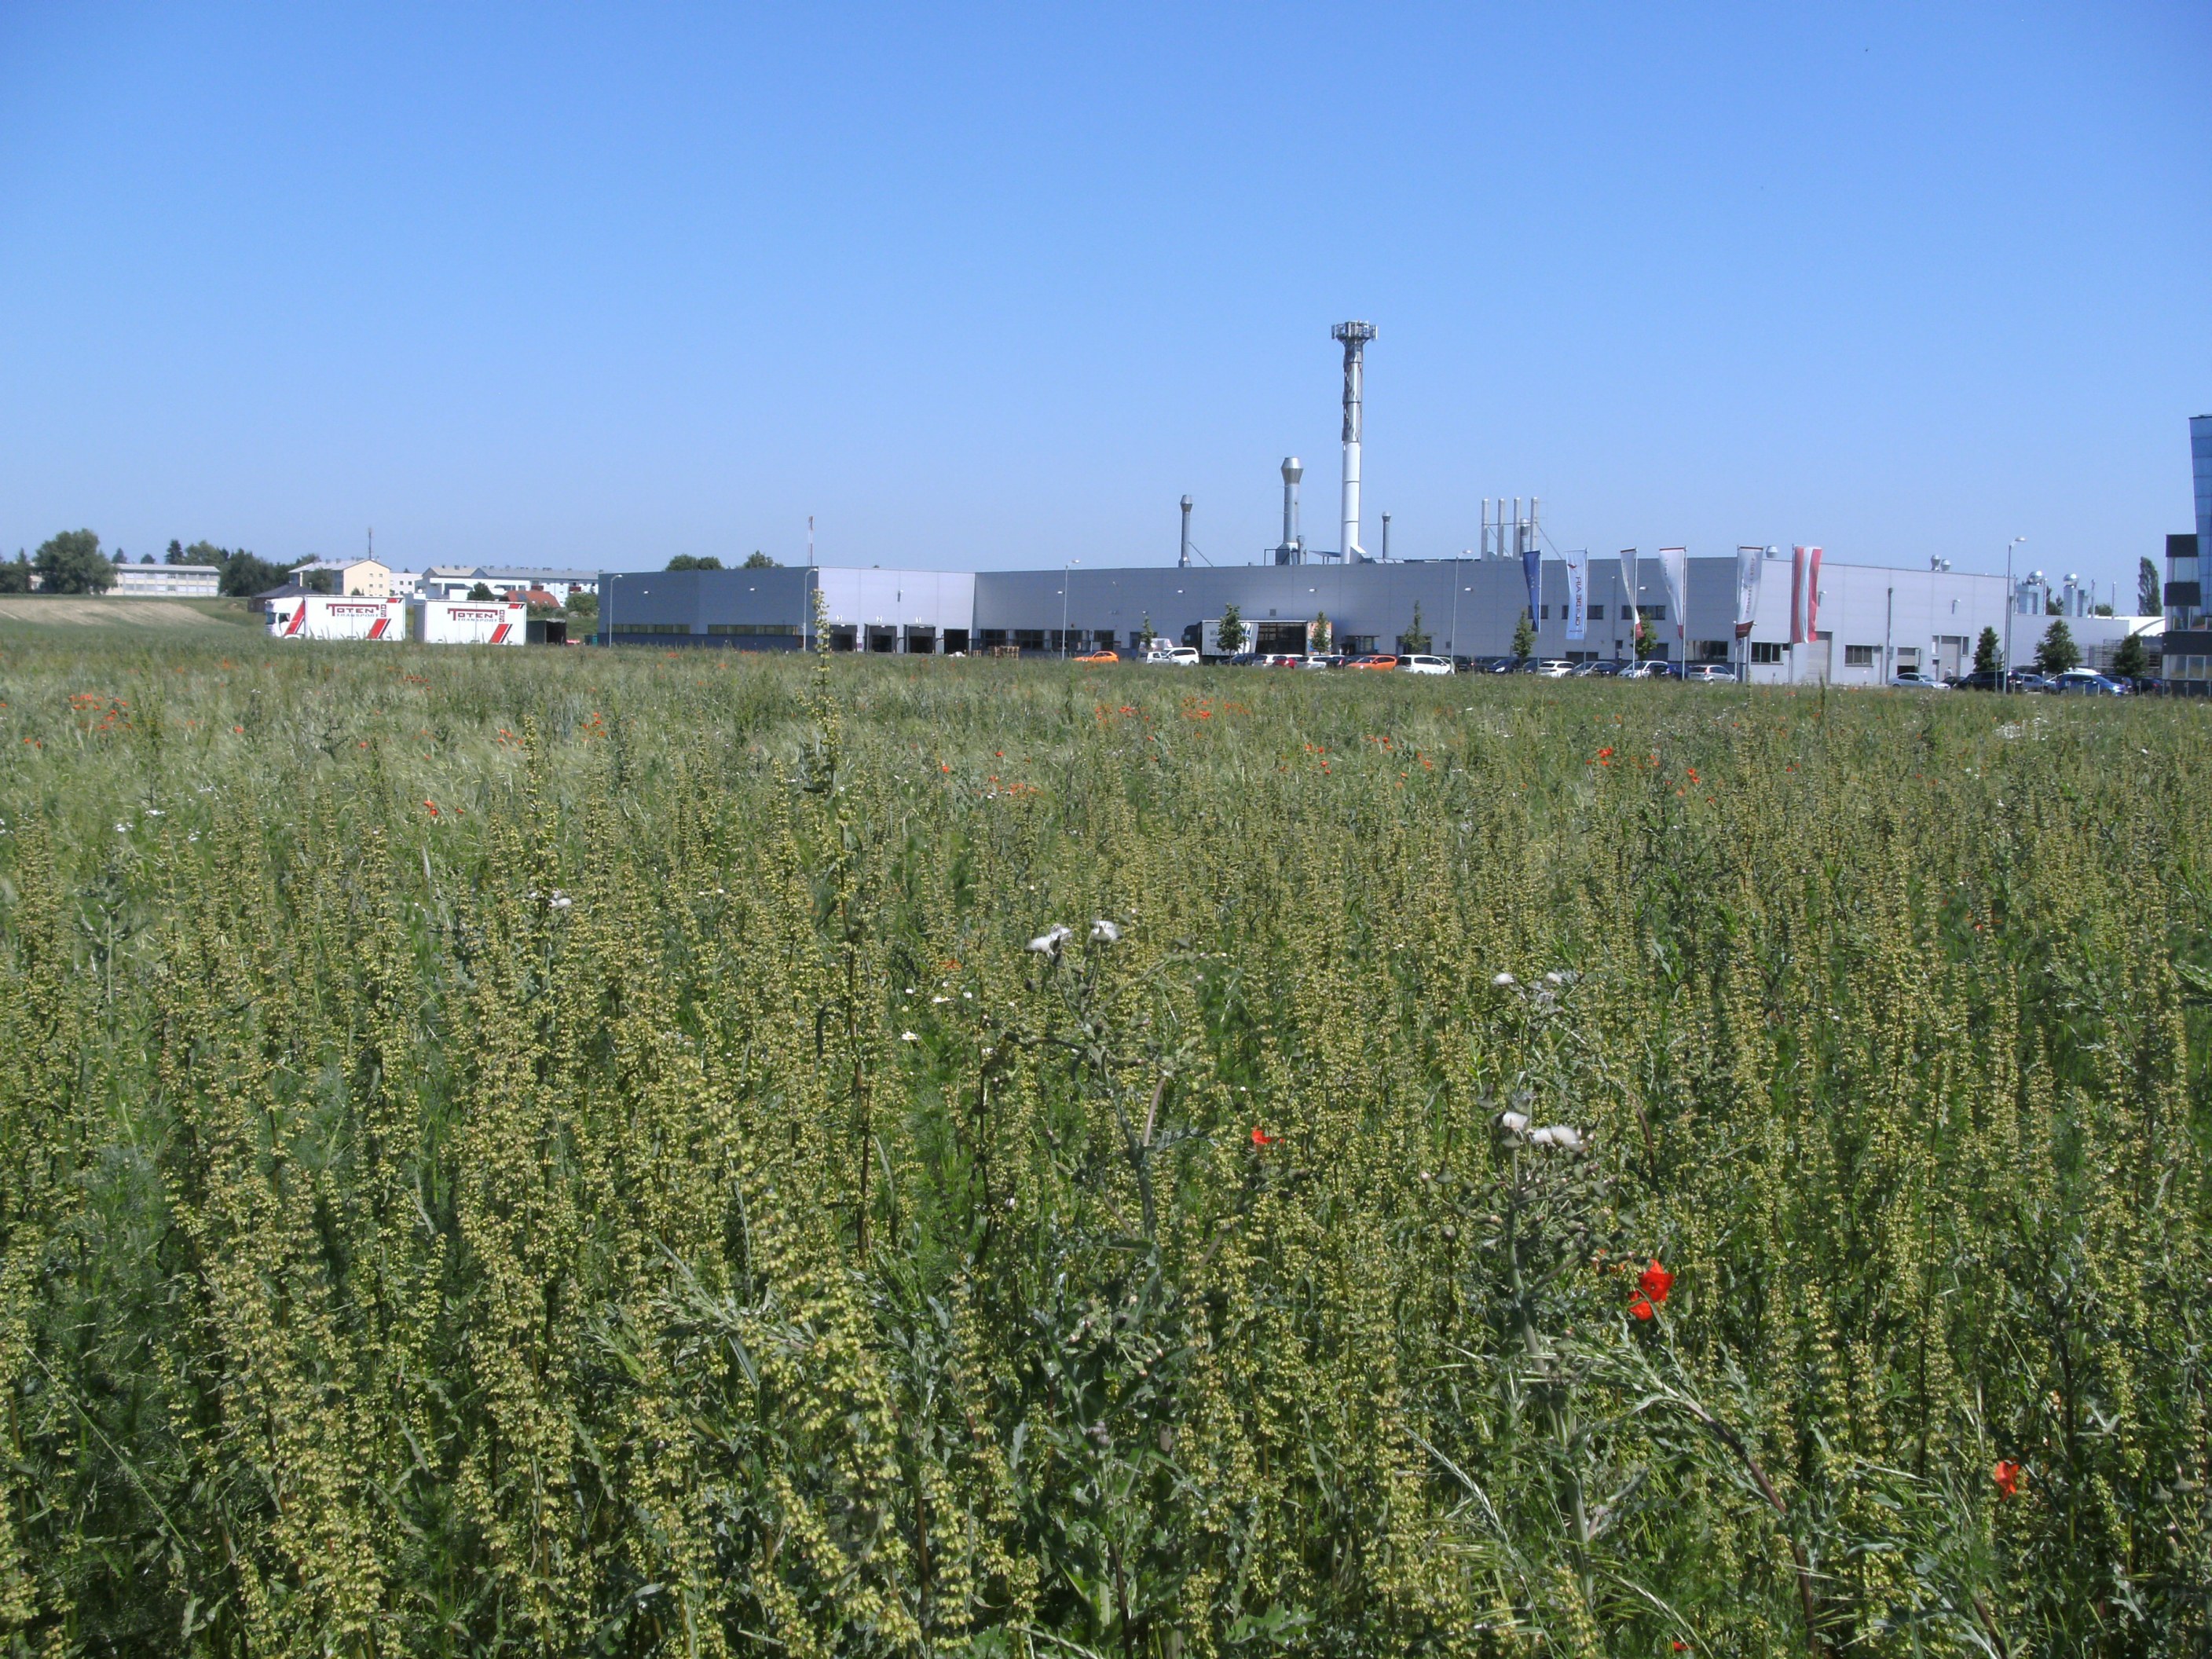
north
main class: Grassland
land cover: Spontaneously vegetated surfaces
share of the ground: > 75 %
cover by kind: herbaceous plants 100 %
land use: Fallow land
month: June
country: AT
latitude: 48.2162
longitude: 14.1856
